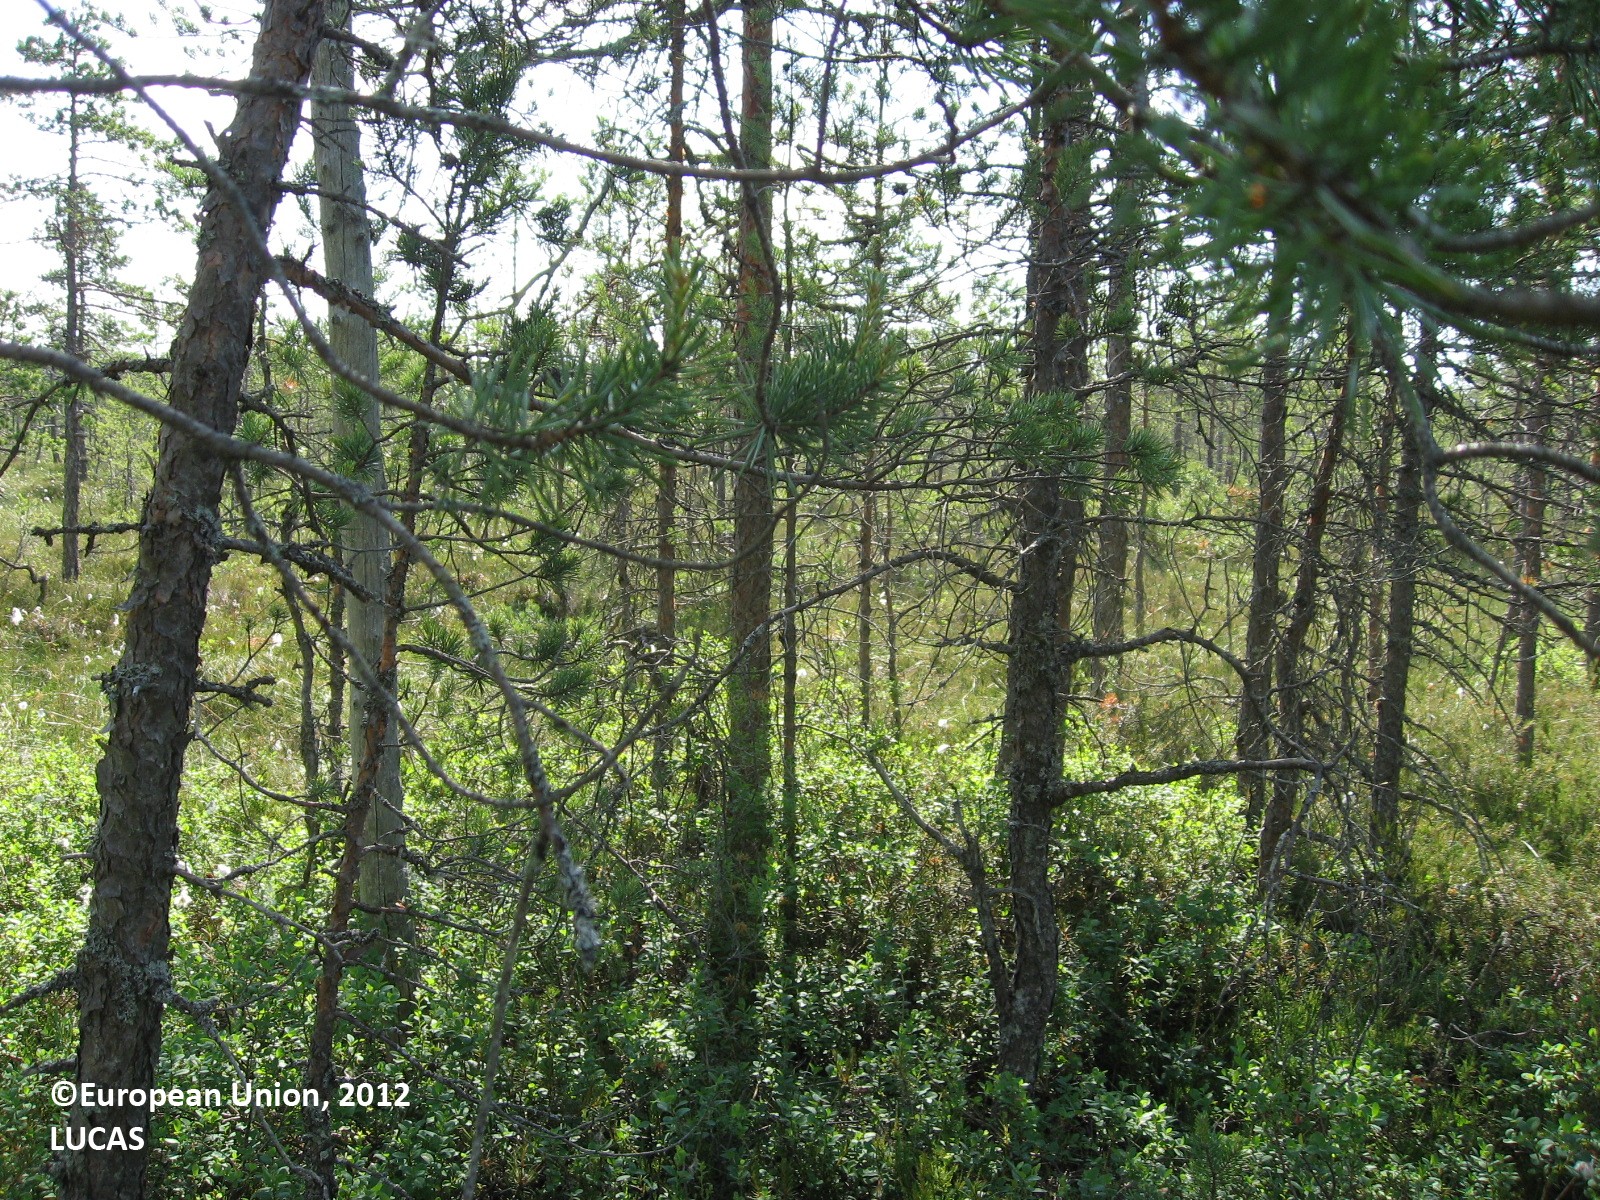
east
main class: Woodland
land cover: Pine dominated coniferous woodland
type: boreal forest
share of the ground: 25 - 50 %
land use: Forestry
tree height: < 5 m
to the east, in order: Pine dominated coniferous woodland; Inland marshes
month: July
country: FI
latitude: 60.8661
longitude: 26.4474
